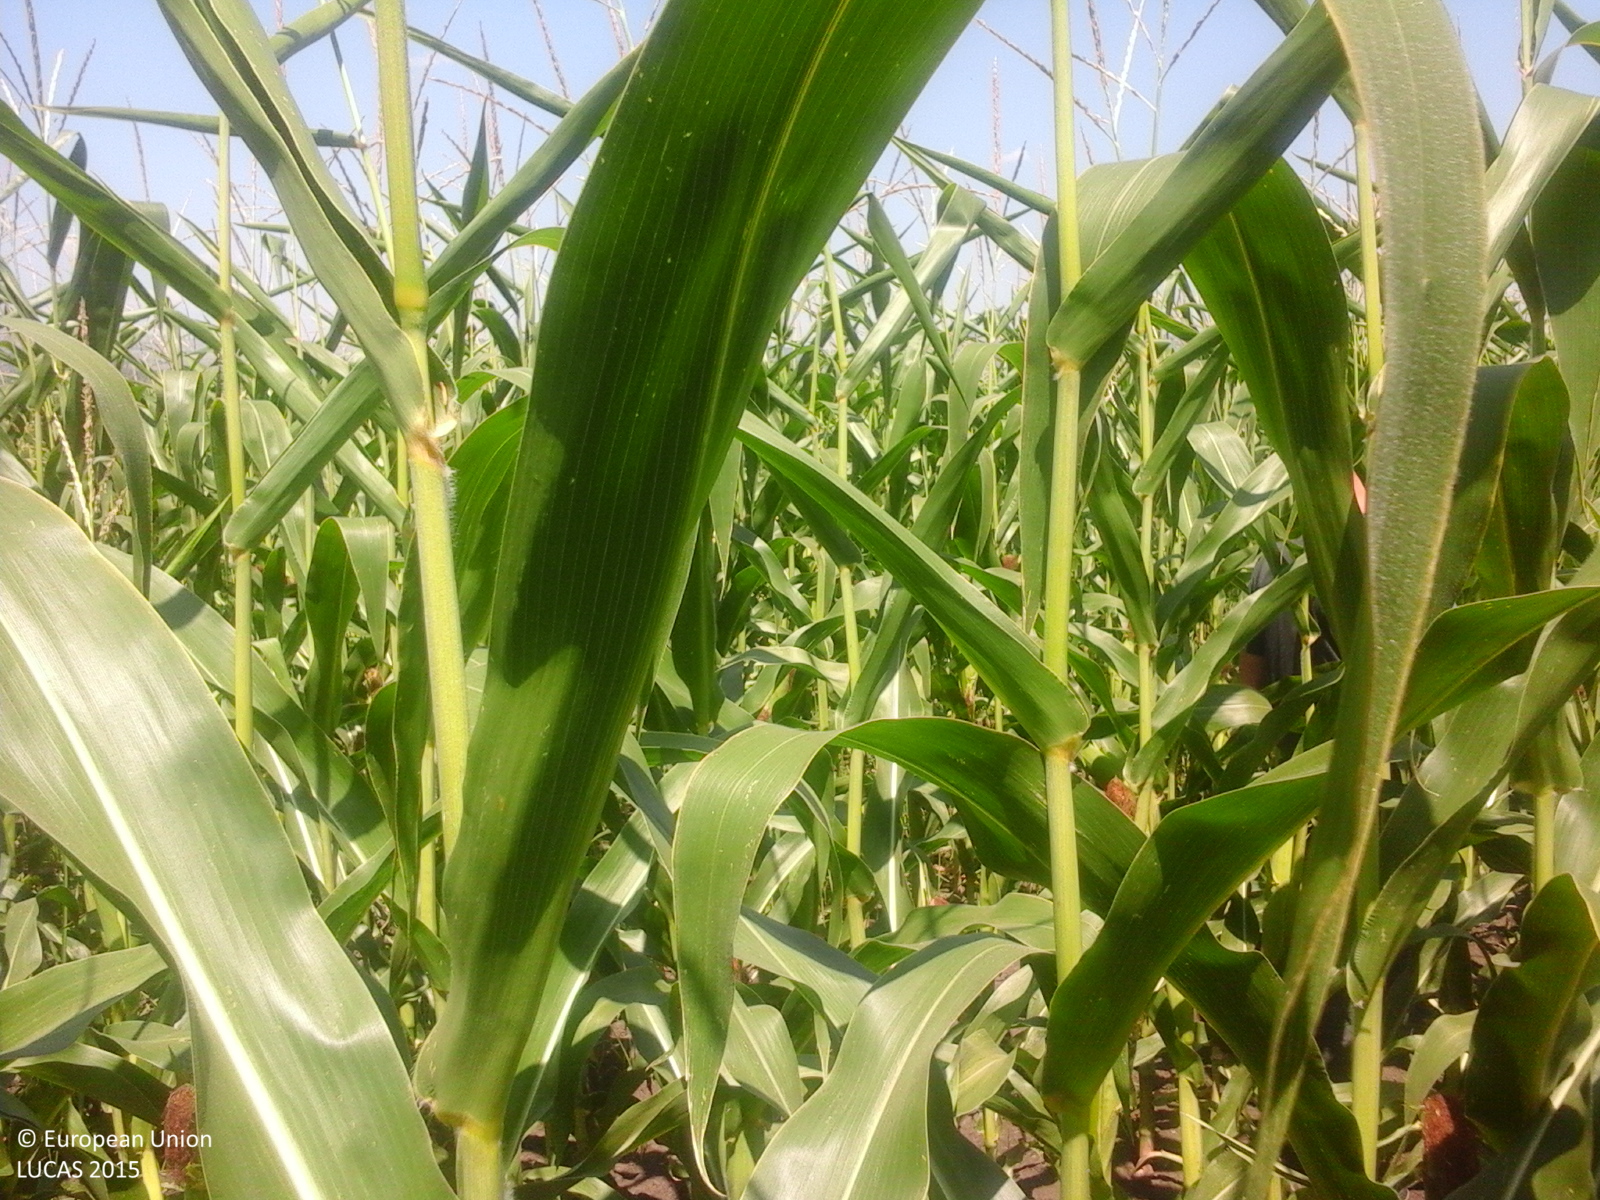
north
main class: Cropland
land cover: Maize
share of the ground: > 75 %
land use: Agriculture (excluding fallow land and kitchen gardens)
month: July
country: RO
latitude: 45.0114
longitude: 26.4495
